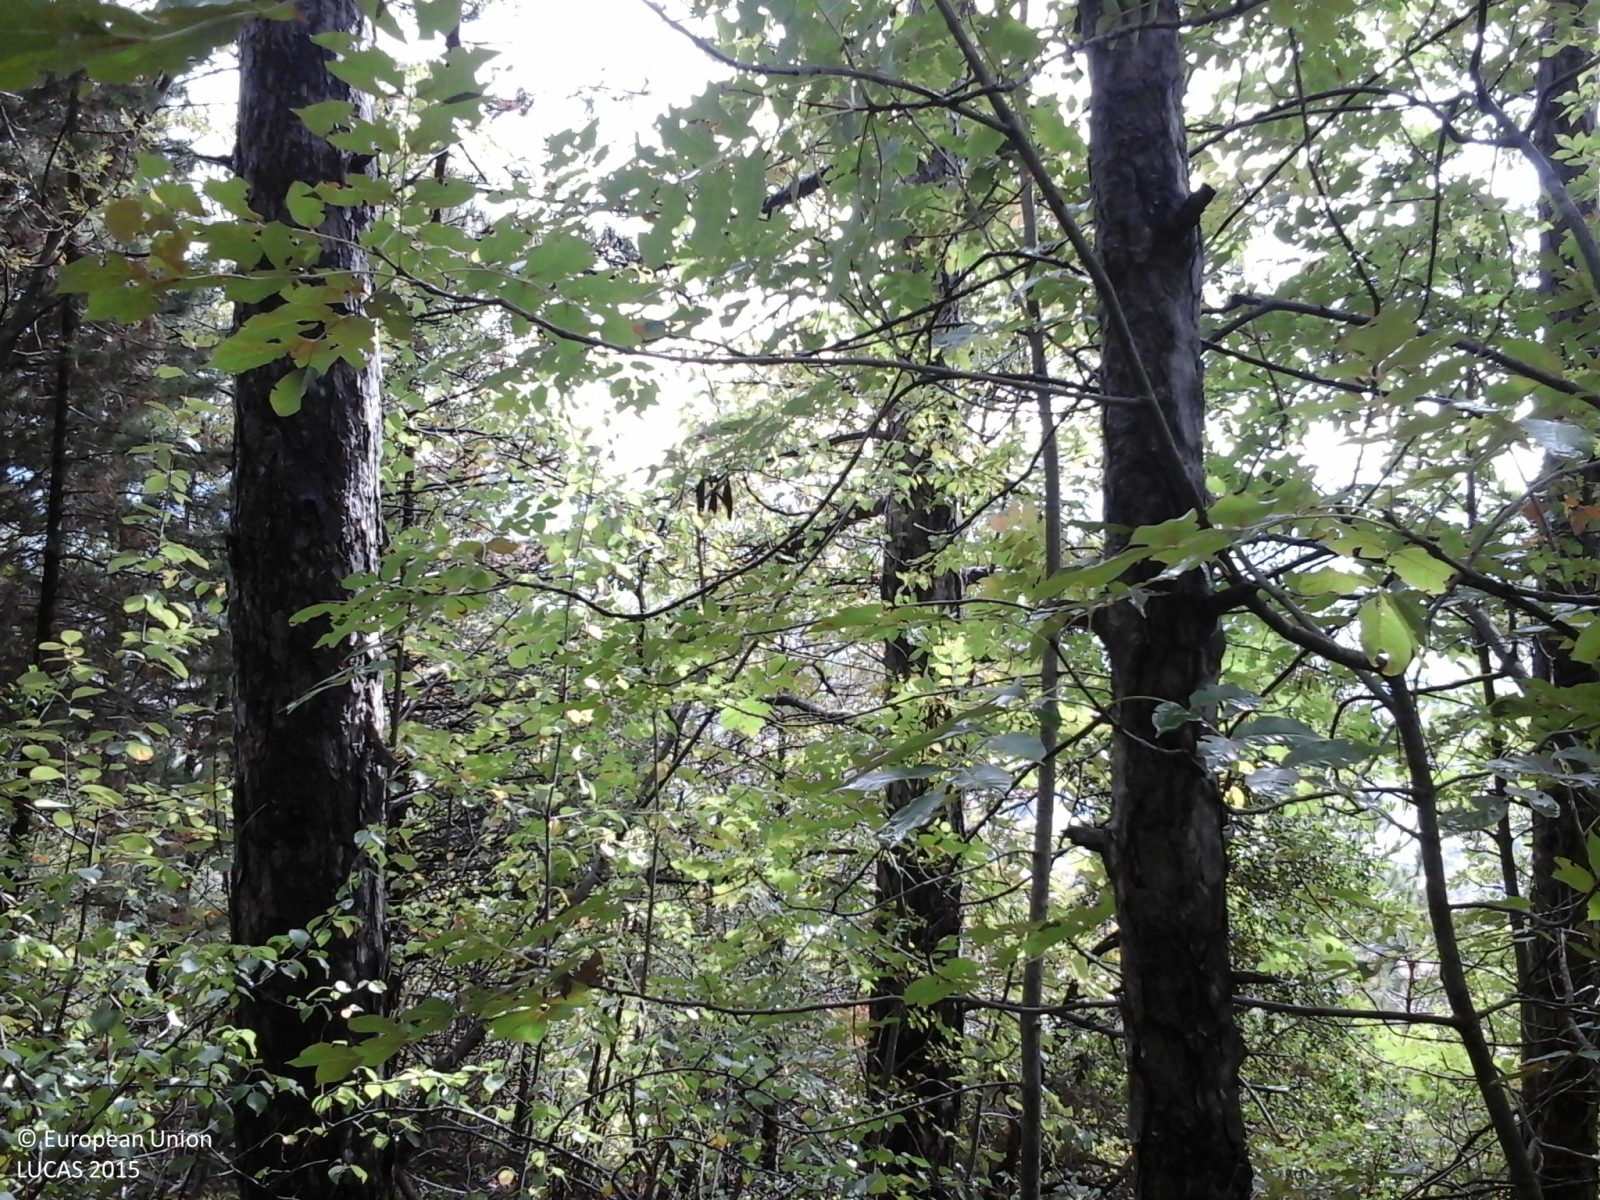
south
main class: Woodland
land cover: Pine dominated mixed woodland
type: coniferous forest of the mediterranean region
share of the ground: > 75 %
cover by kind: coniferous forest trees 50 %, broadleaved forest trees 25 %, shrubs 15 %, herbaceous plants 10 %
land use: Forestry
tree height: > 5 m
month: October
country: IT
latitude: 43.3620
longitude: 12.5720
